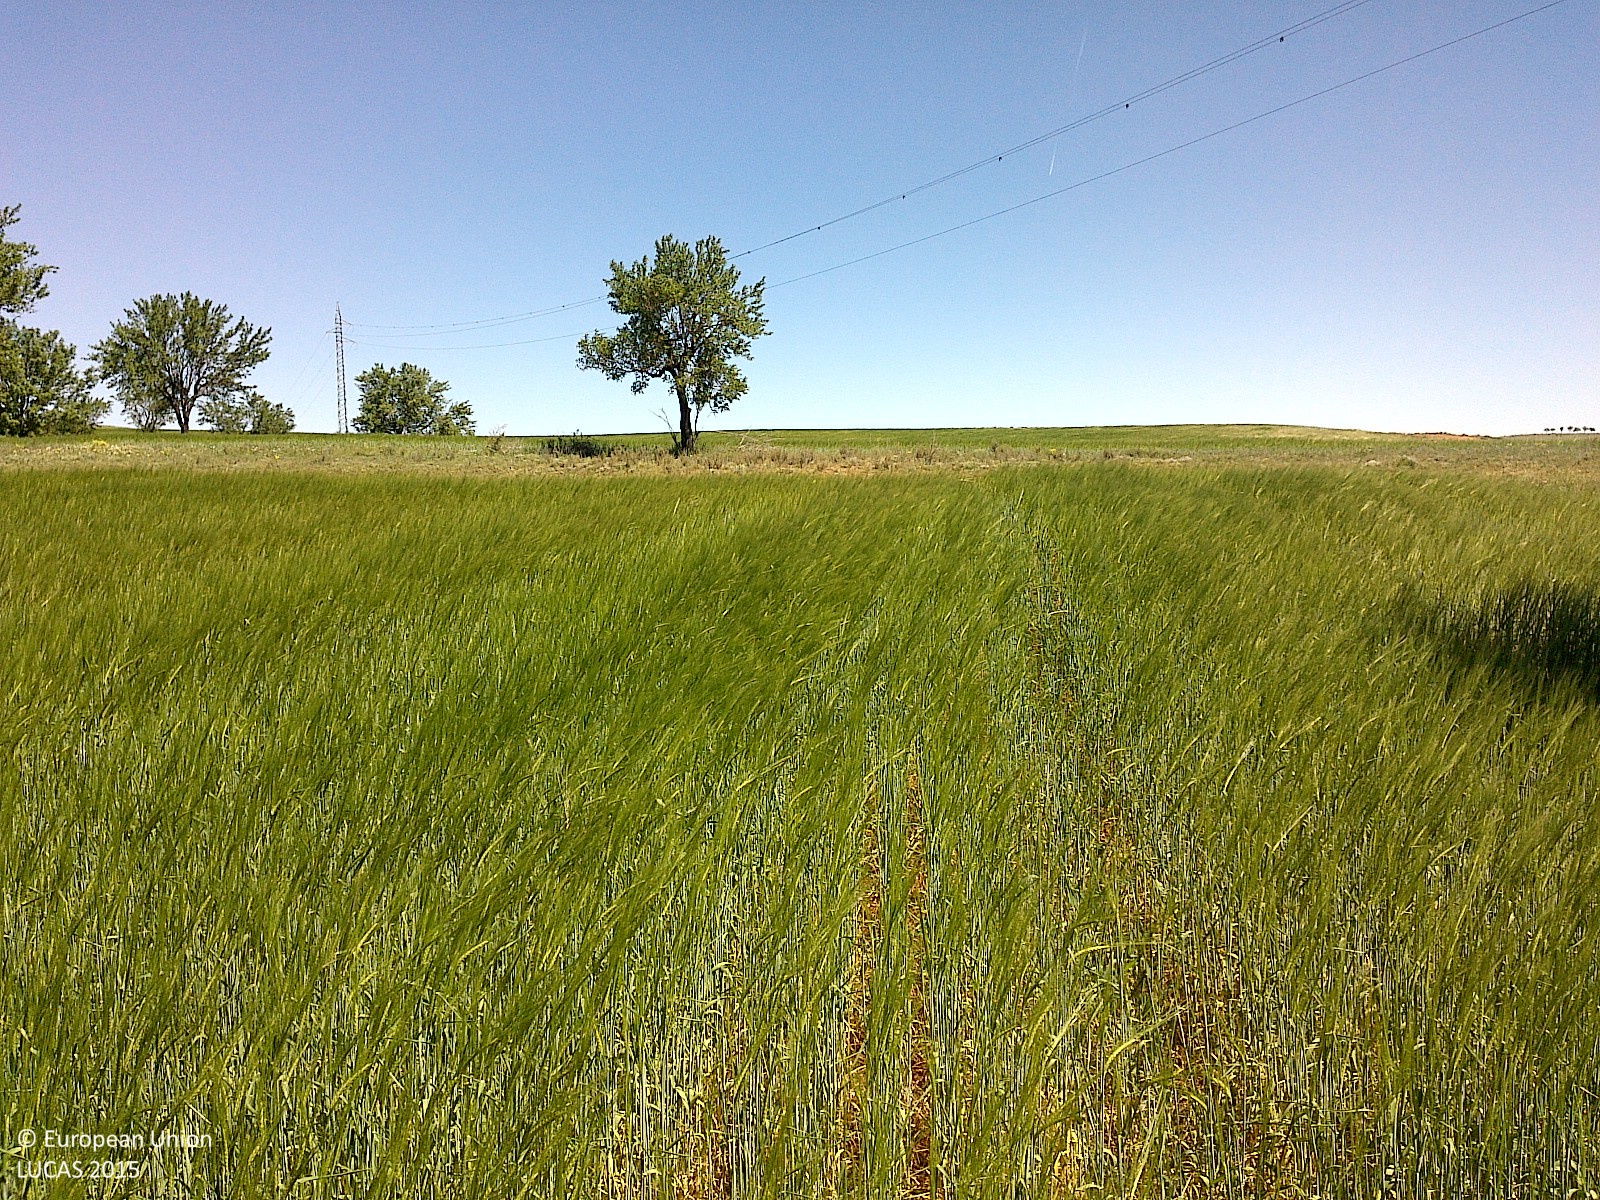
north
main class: Cropland
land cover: Barley
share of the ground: > 75 %
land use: Agriculture (excluding fallow land and kitchen gardens)
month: May
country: ES
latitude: 41.5614
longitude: -3.1015
